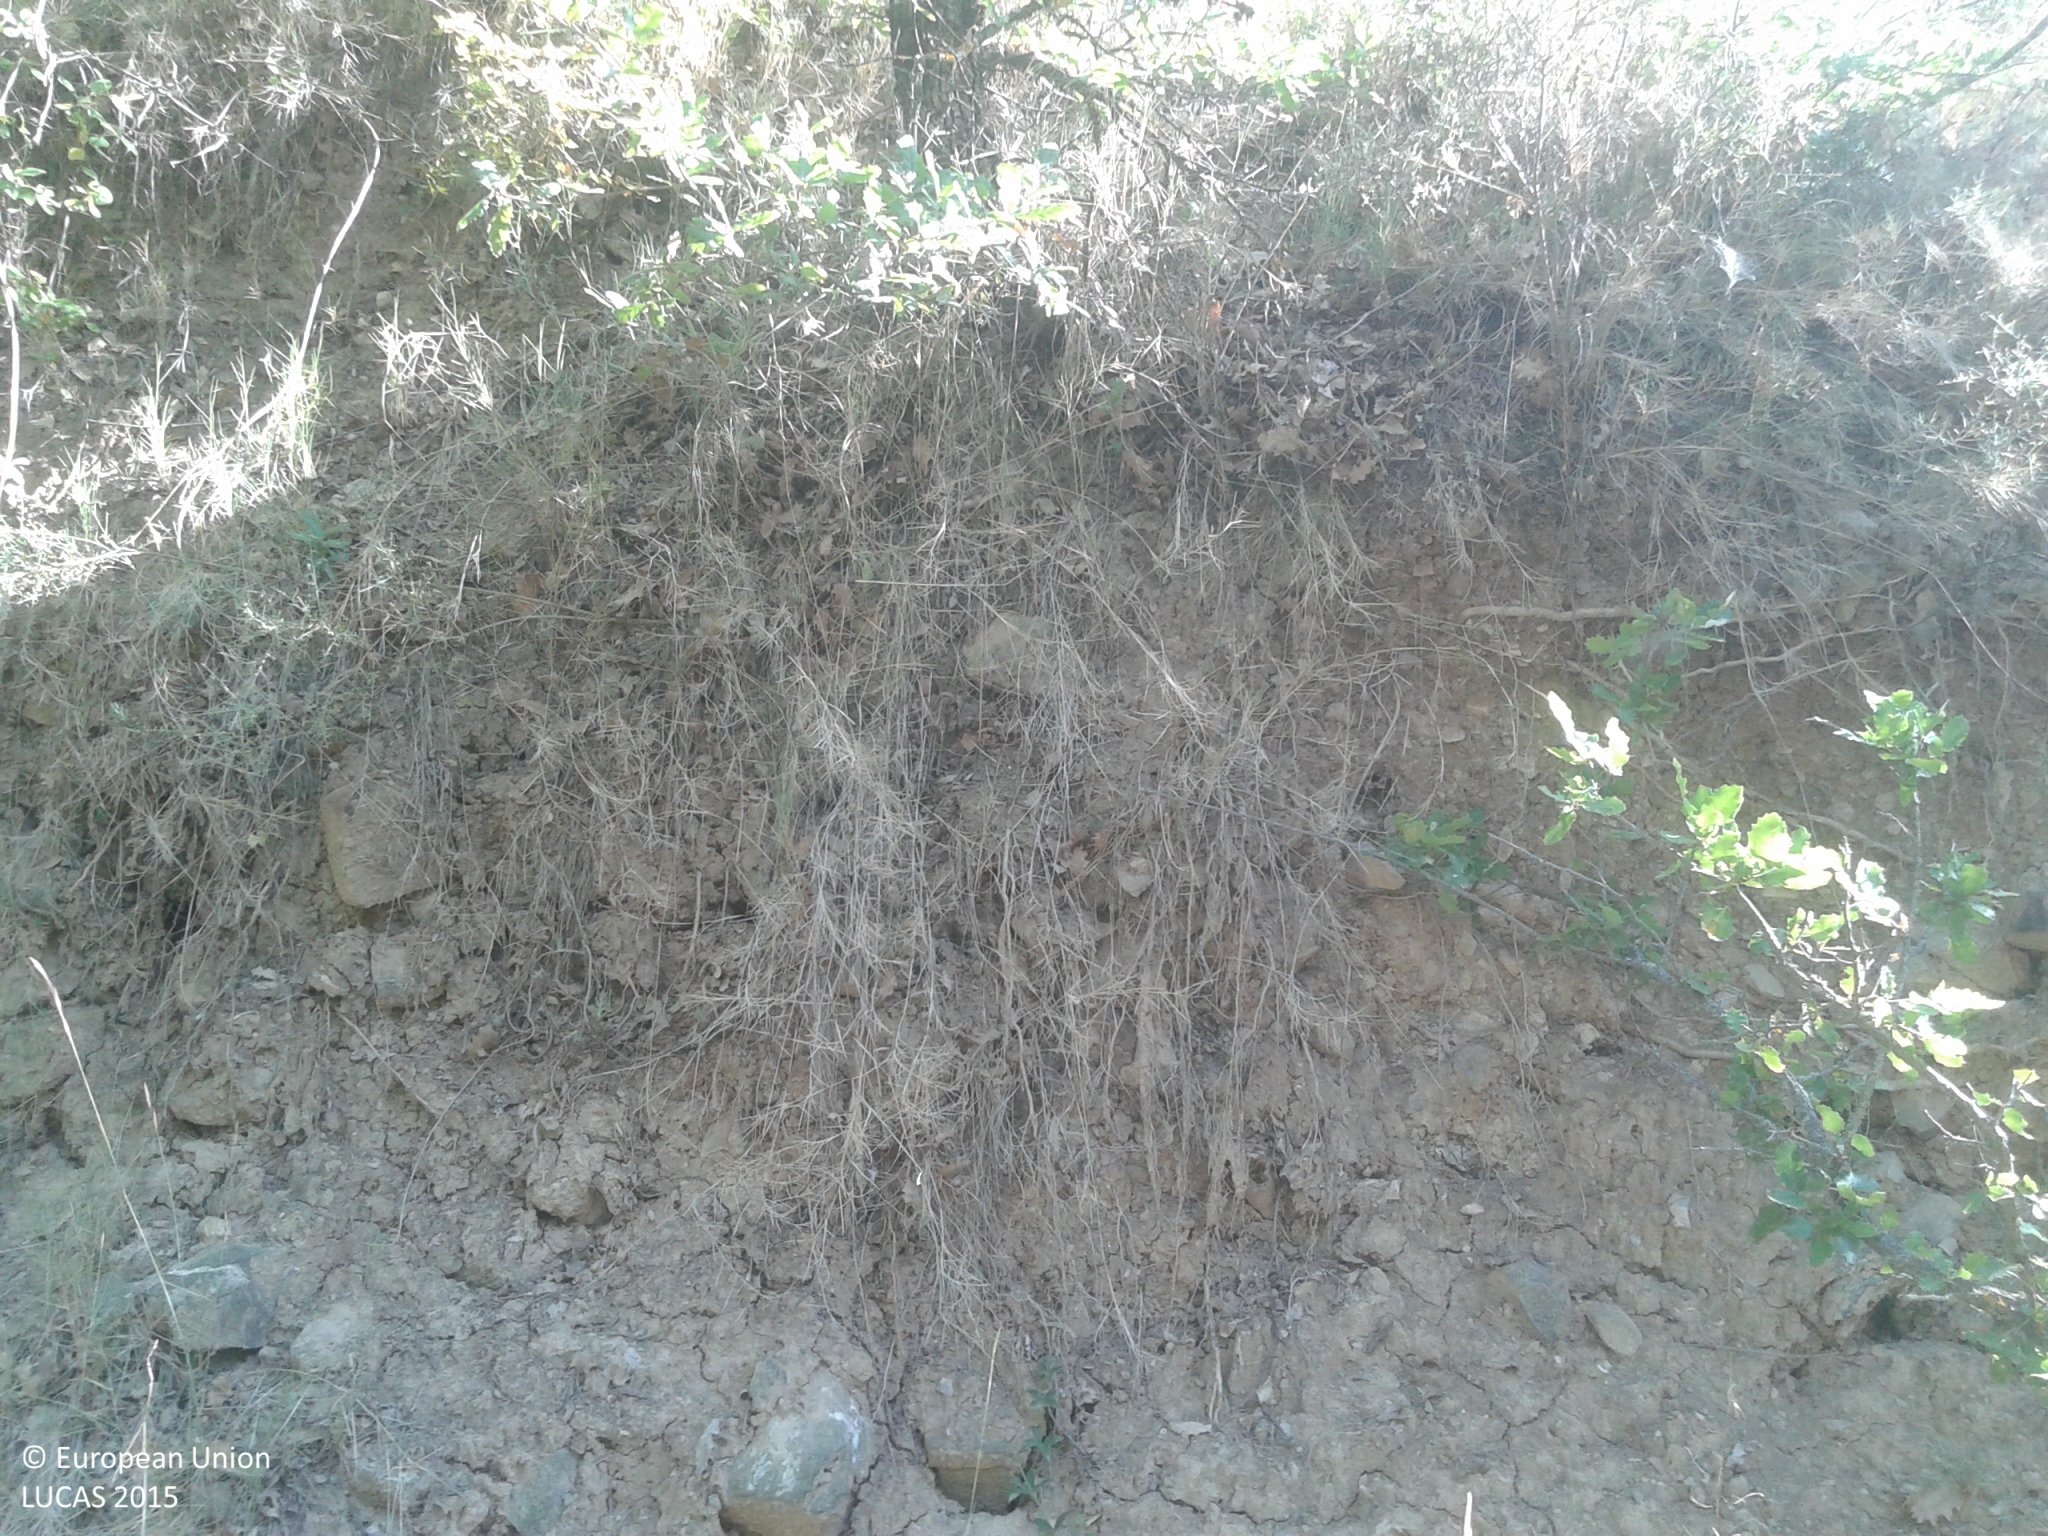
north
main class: Woodland
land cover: Broadleaved woodland
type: broadleaved evergreen forest
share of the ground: 50 - 75 %
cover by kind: broadleaved forest trees 50 %, shrubs 35 %, herbaceous plants 10 %, consolidated bare surface 5 %
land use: Semi-natural and natural areas not in use
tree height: > 5 m
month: July
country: ES
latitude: 42.3131
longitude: 1.0671
